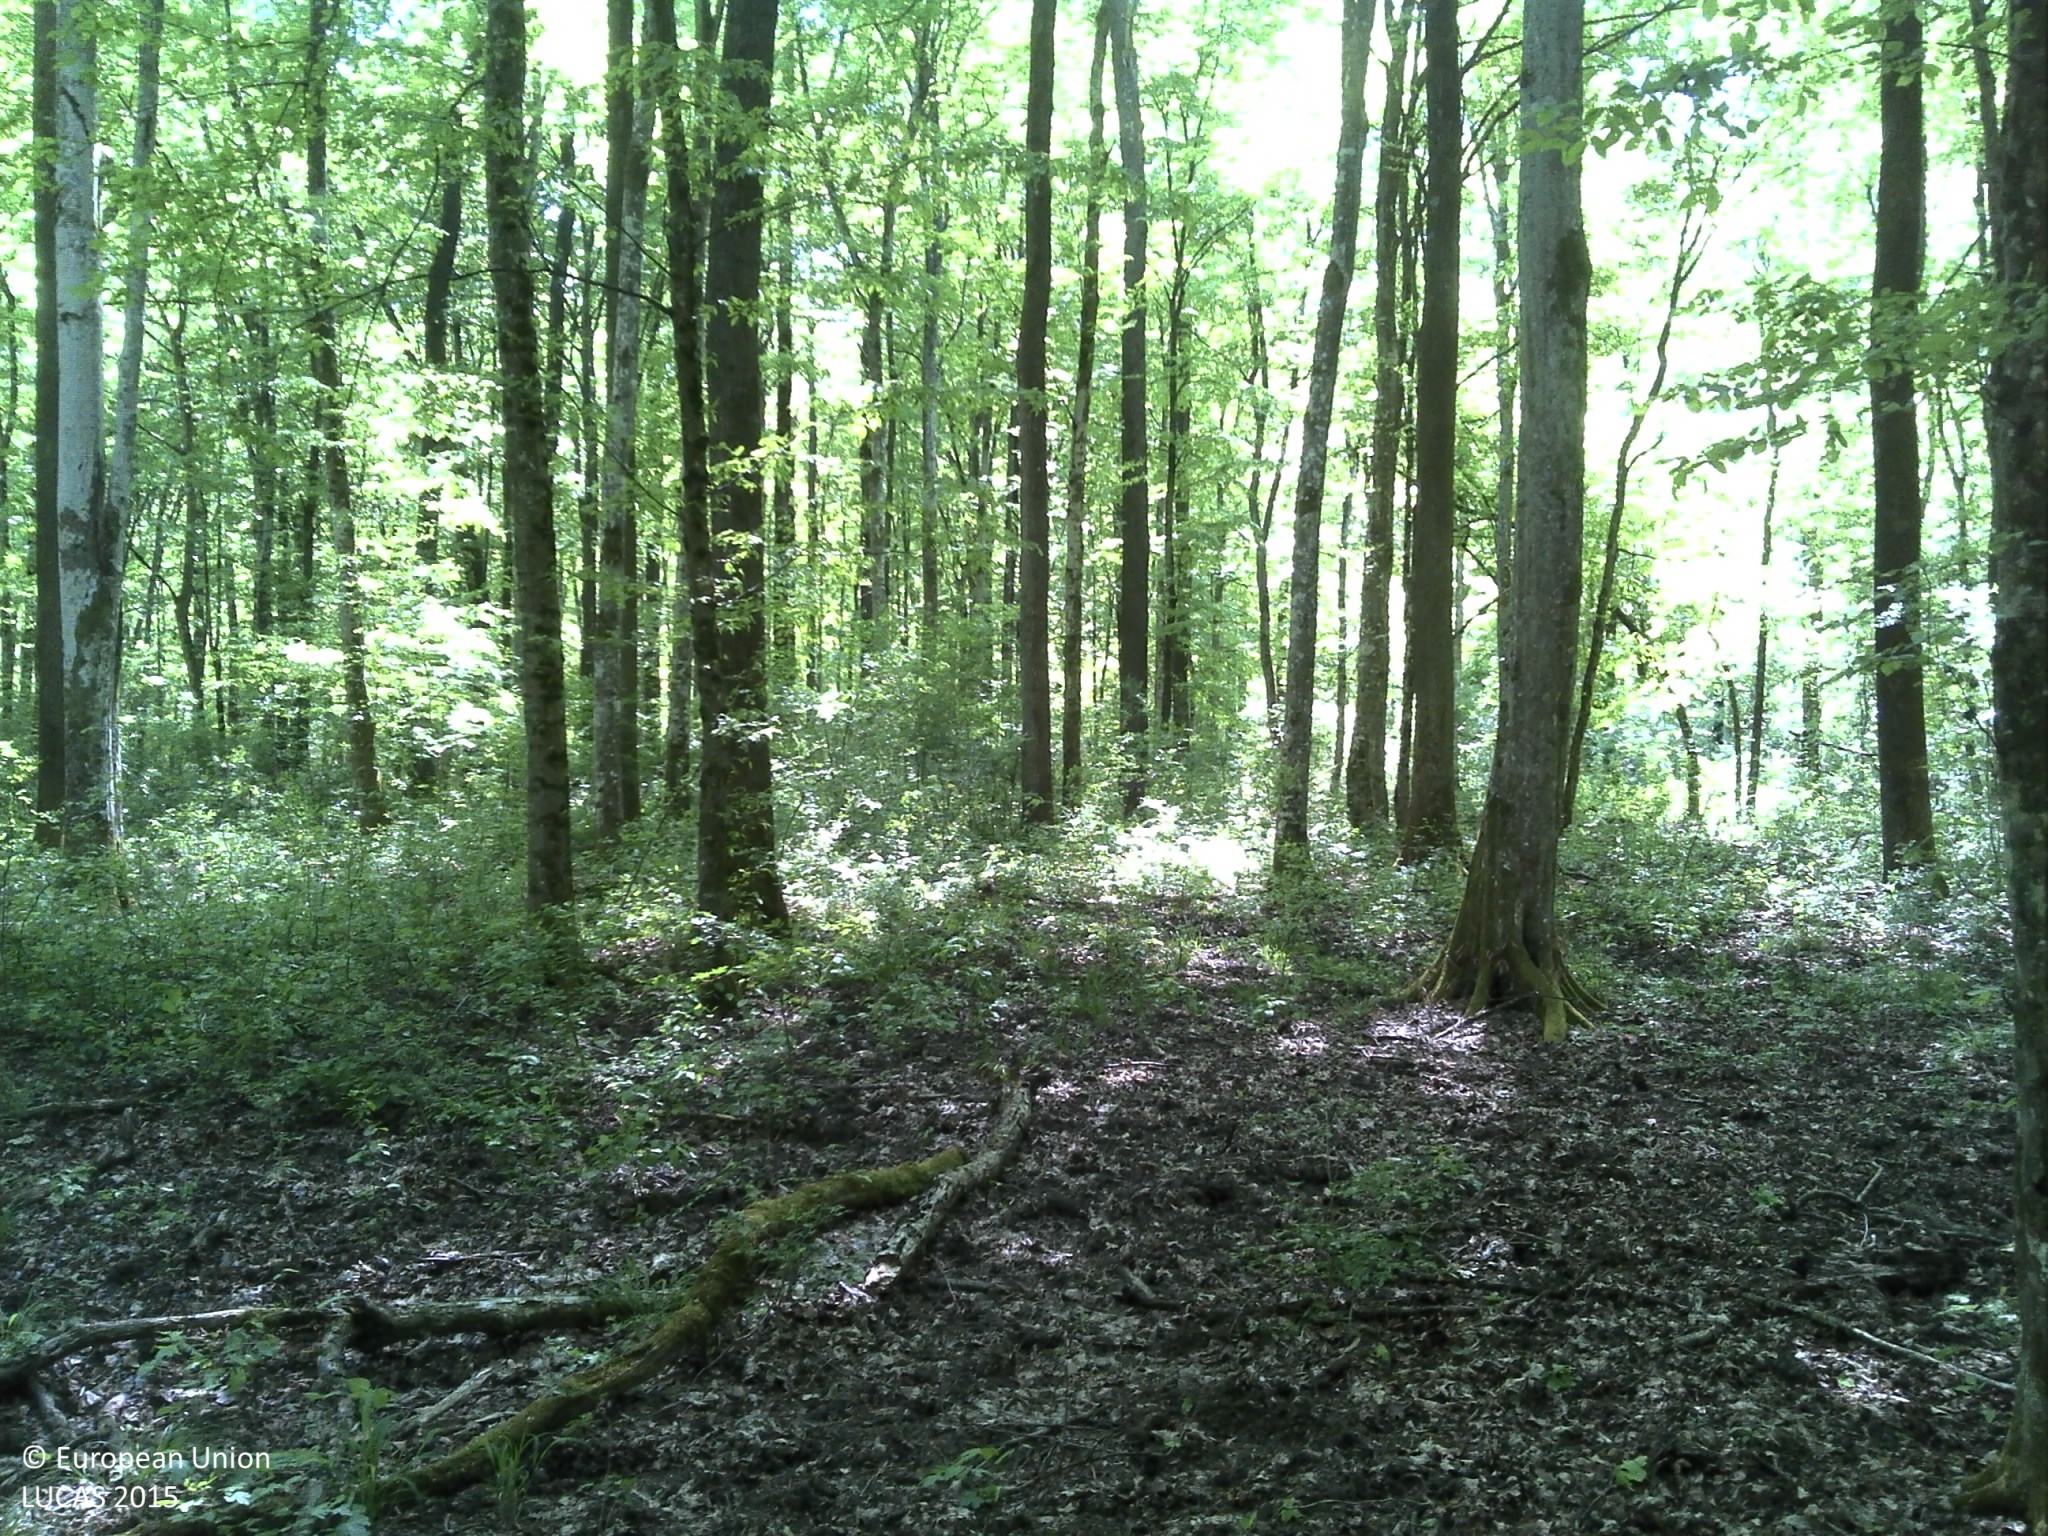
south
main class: Woodland
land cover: Broadleaved woodland
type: mesophytic deciduous forest
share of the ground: > 75 %
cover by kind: broadleaved forest trees 100 %
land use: Forestry
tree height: > 5 m
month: April
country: HR
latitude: 45.0504
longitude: 18.9585
